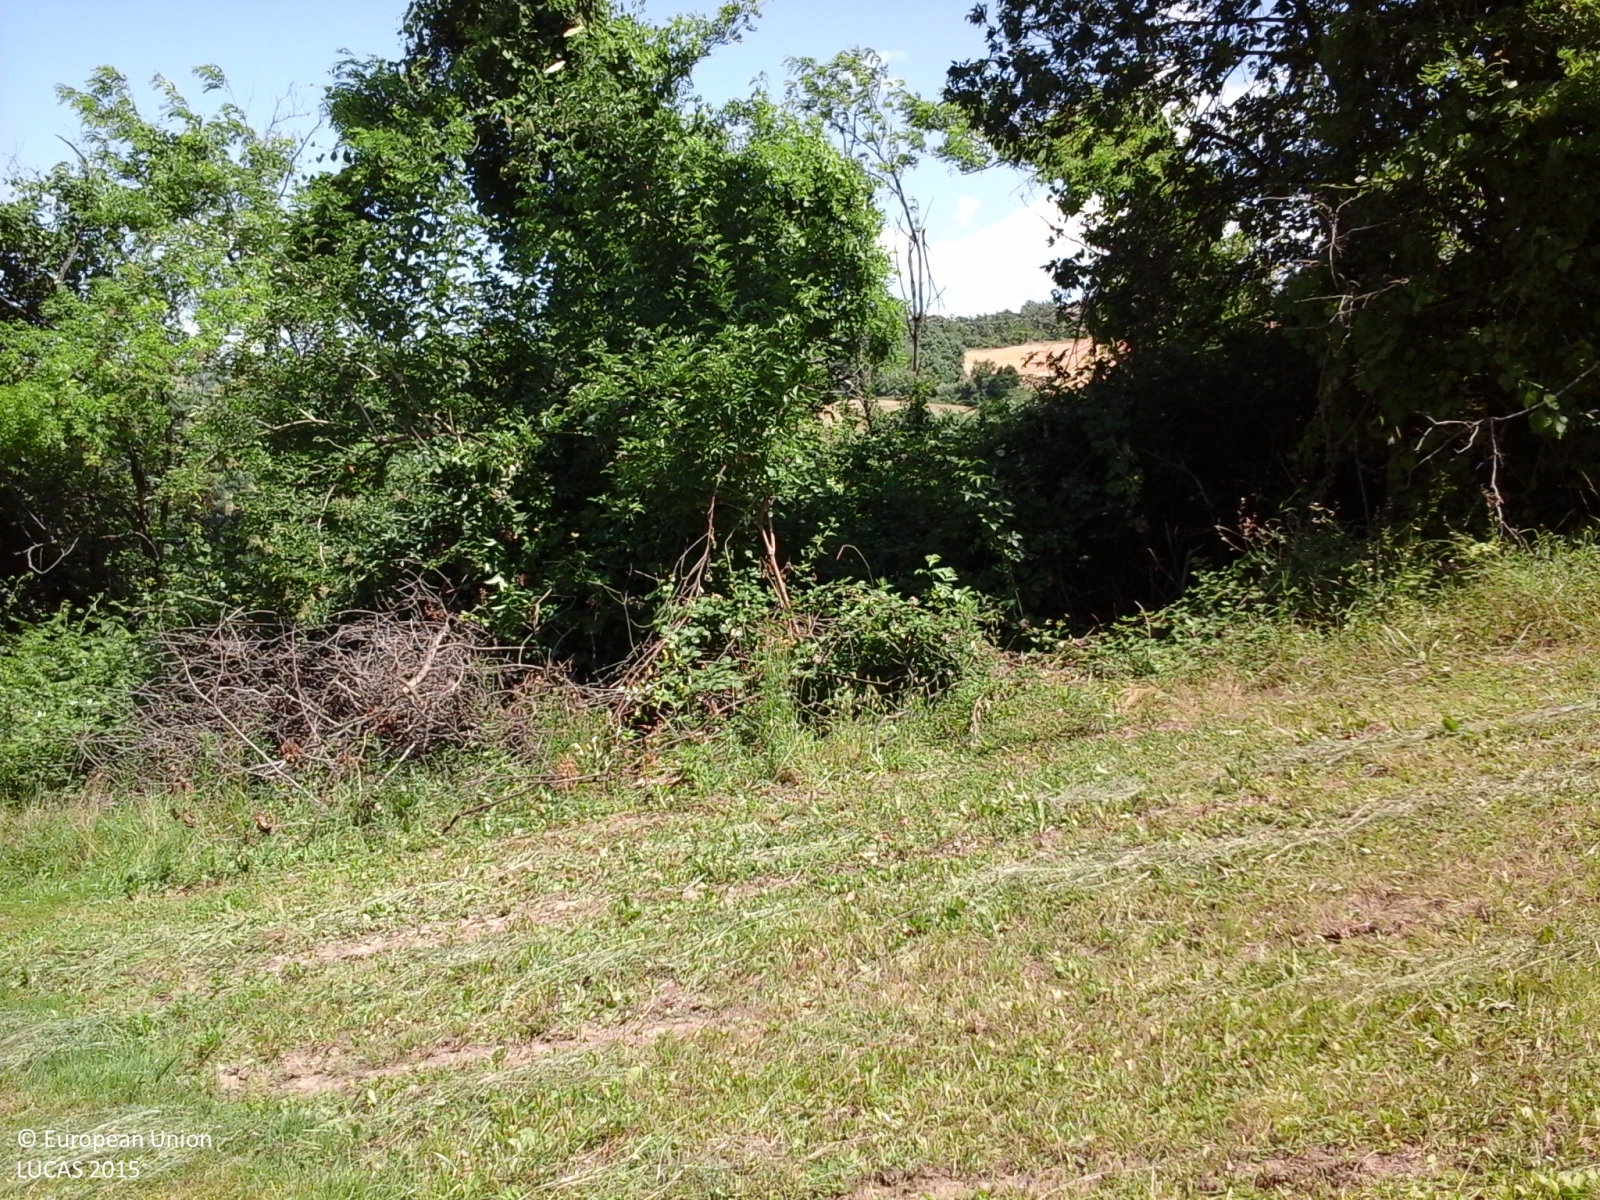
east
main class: Grassland
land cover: Grassland without tree/shrub cover
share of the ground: > 75 %
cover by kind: herbaceous plants 100 %
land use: Agriculture (excluding fallow land and kitchen gardens)
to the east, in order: Grassland without tree/shrub cover; Abandoned hedges; Inland fresh running water; Abandoned hedges; Barley; Grassland without tree/shrub cover; Electric lines; Grassland without tree/shrub cover; Abandoned hedges; Inland fresh running water; Abandoned hedges
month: June
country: IT
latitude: 44.2486
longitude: 11.5618
